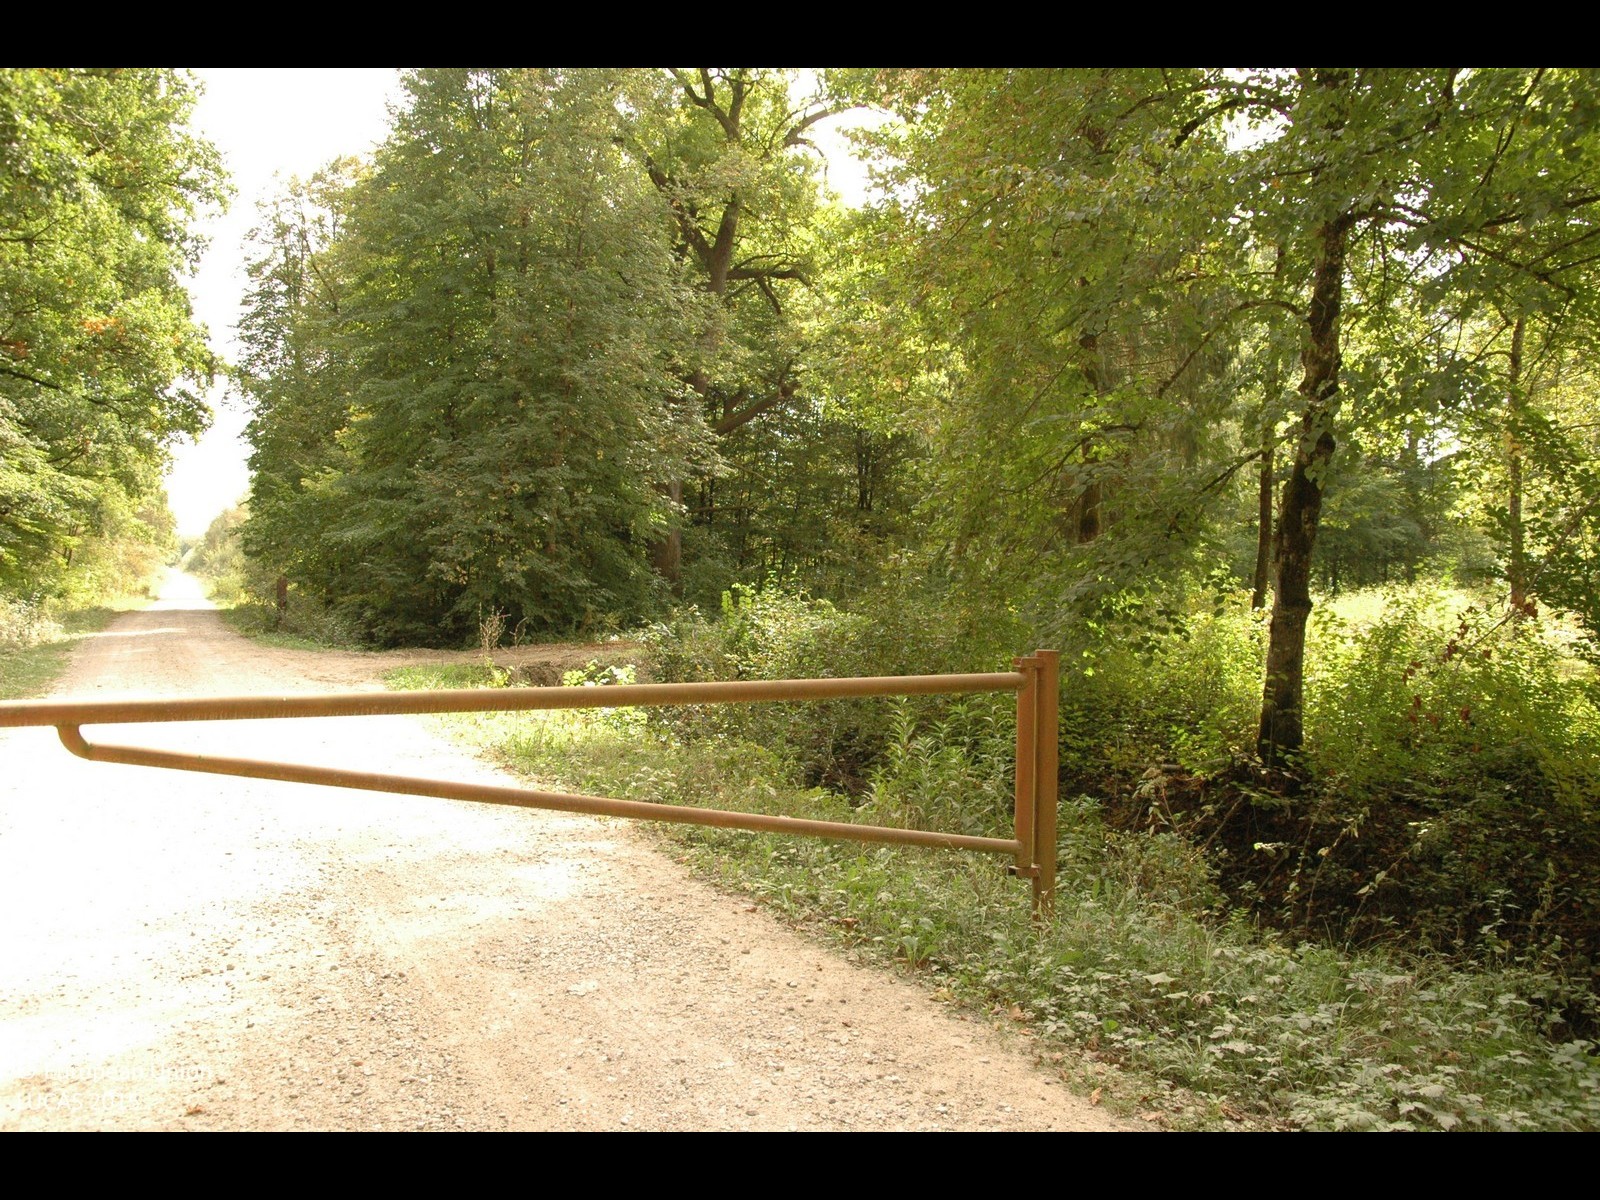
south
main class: Woodland
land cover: Broadleaved woodland
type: mesophytic deciduous forest
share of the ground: > 75 %
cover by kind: broadleaved forest trees 100 %
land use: Forestry
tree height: > 5 m
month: September
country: HR
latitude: 45.6282
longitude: 16.2189
